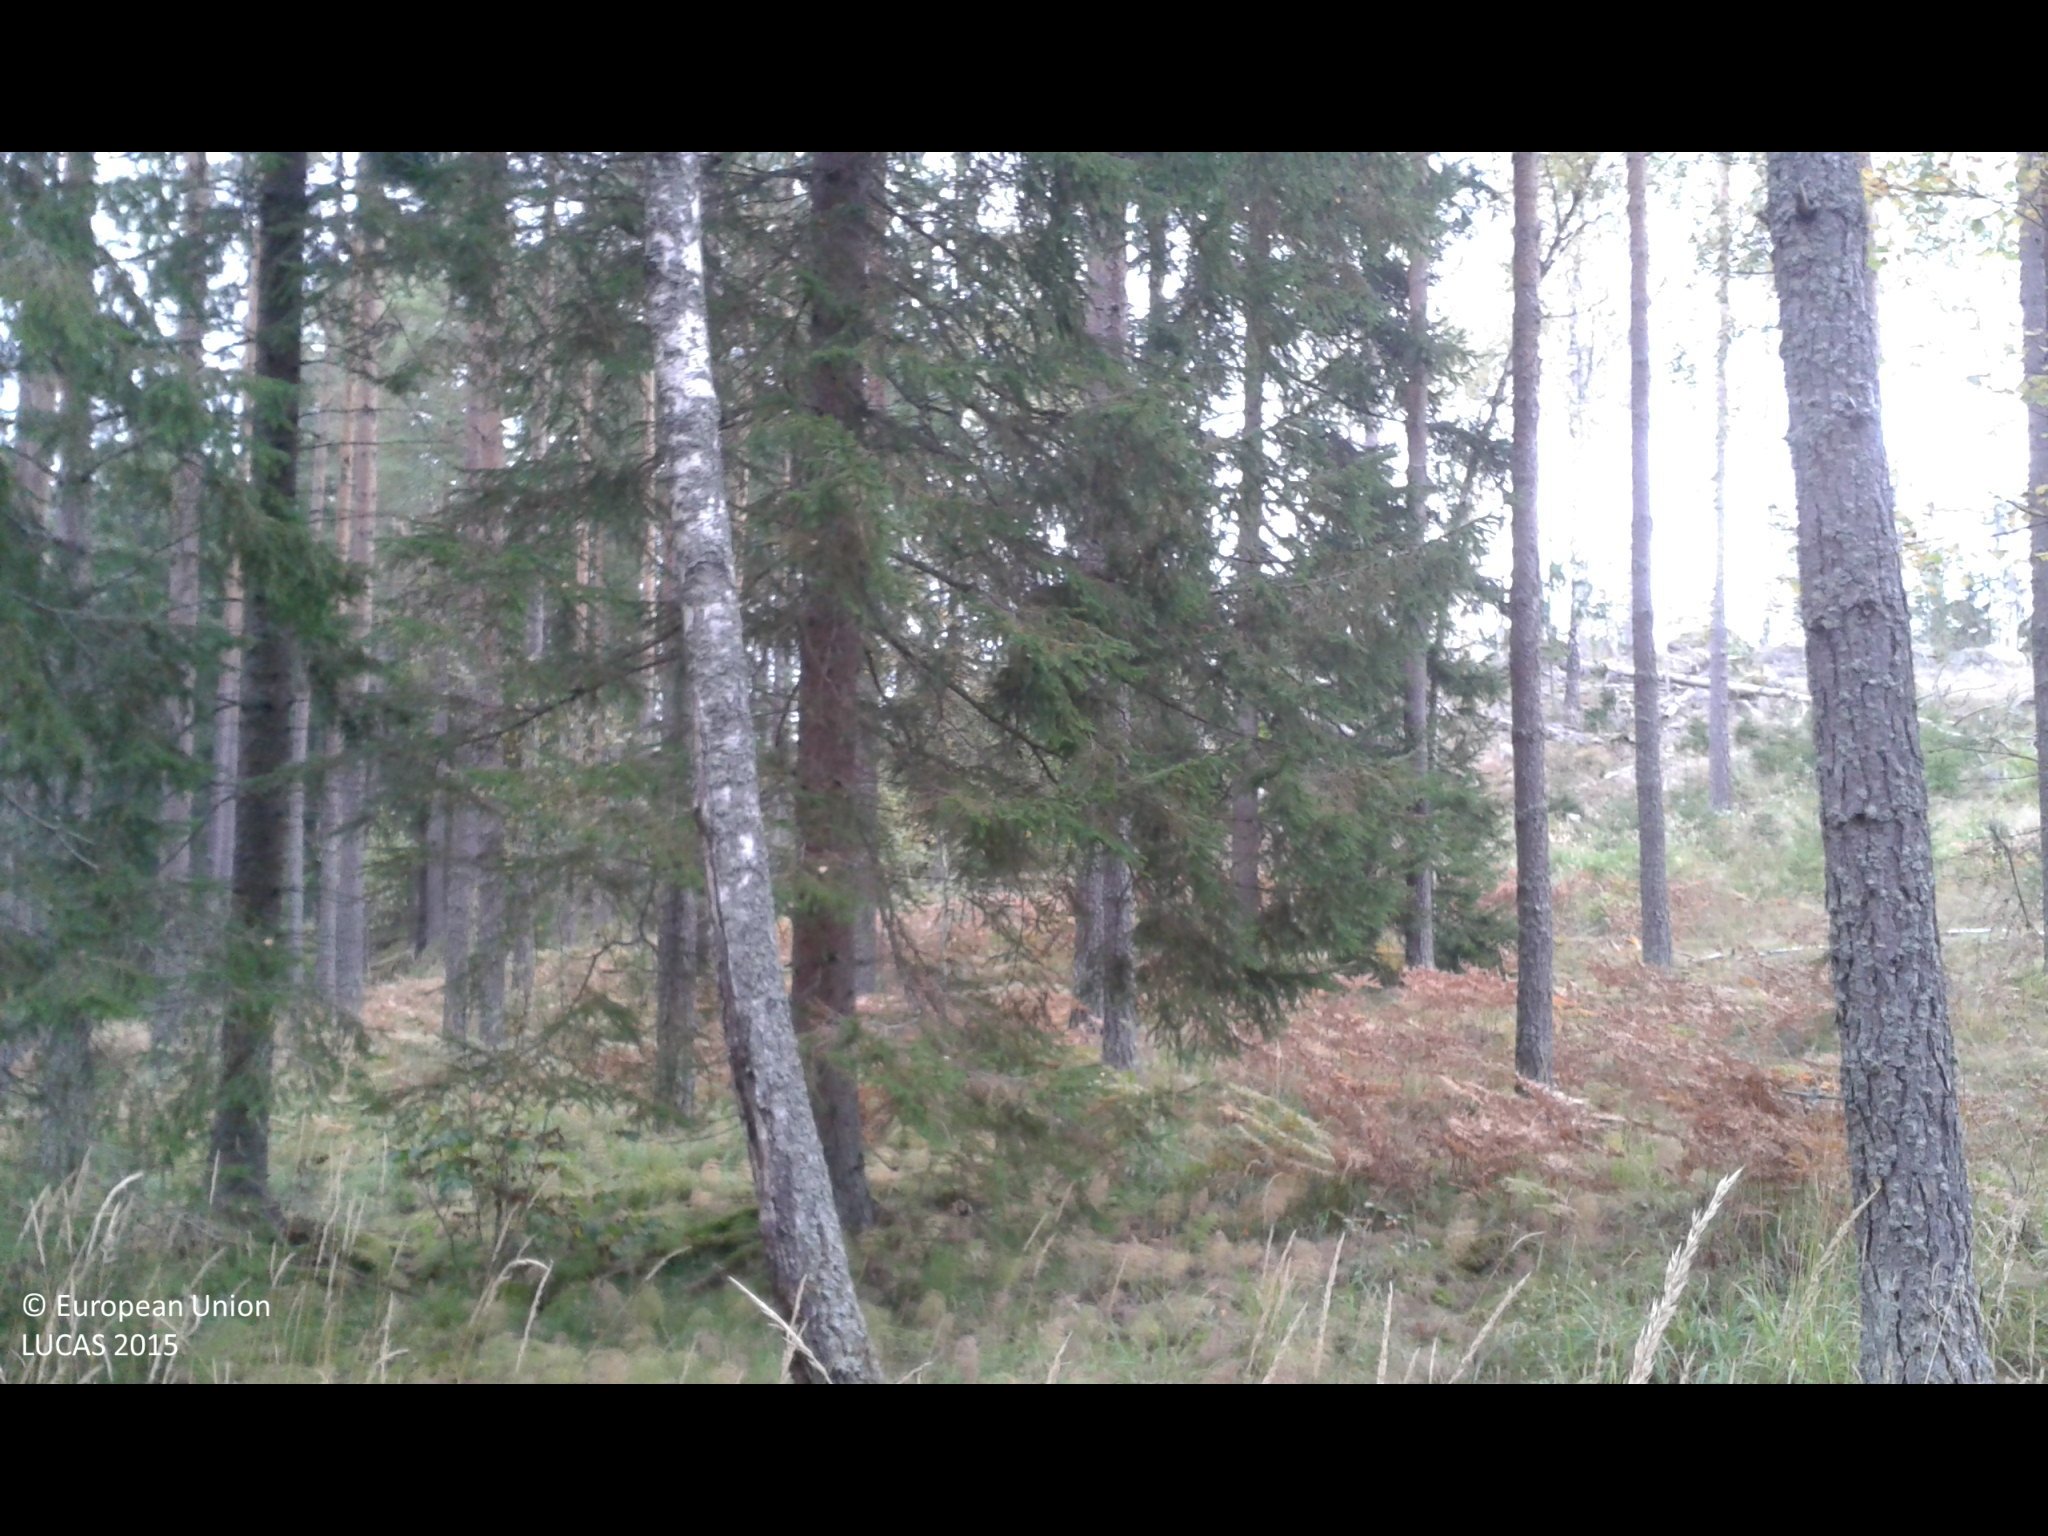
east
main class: Woodland
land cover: Pine dominated coniferous woodland
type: boreal forest
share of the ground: 50 - 75 %
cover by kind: herbaceous plants 50 %, coniferous forest trees 45 %, broadleaved forest trees 5 %
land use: Forestry
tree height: > 5 m
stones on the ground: < 10 %
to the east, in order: Pine dominated coniferous woodland; Broadleaved woodland; Spruce dominated coniferous woodland; Inland fresh water bodies; Pine dominated coniferous woodland
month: September
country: SE
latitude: 59.0437
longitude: 17.4396
